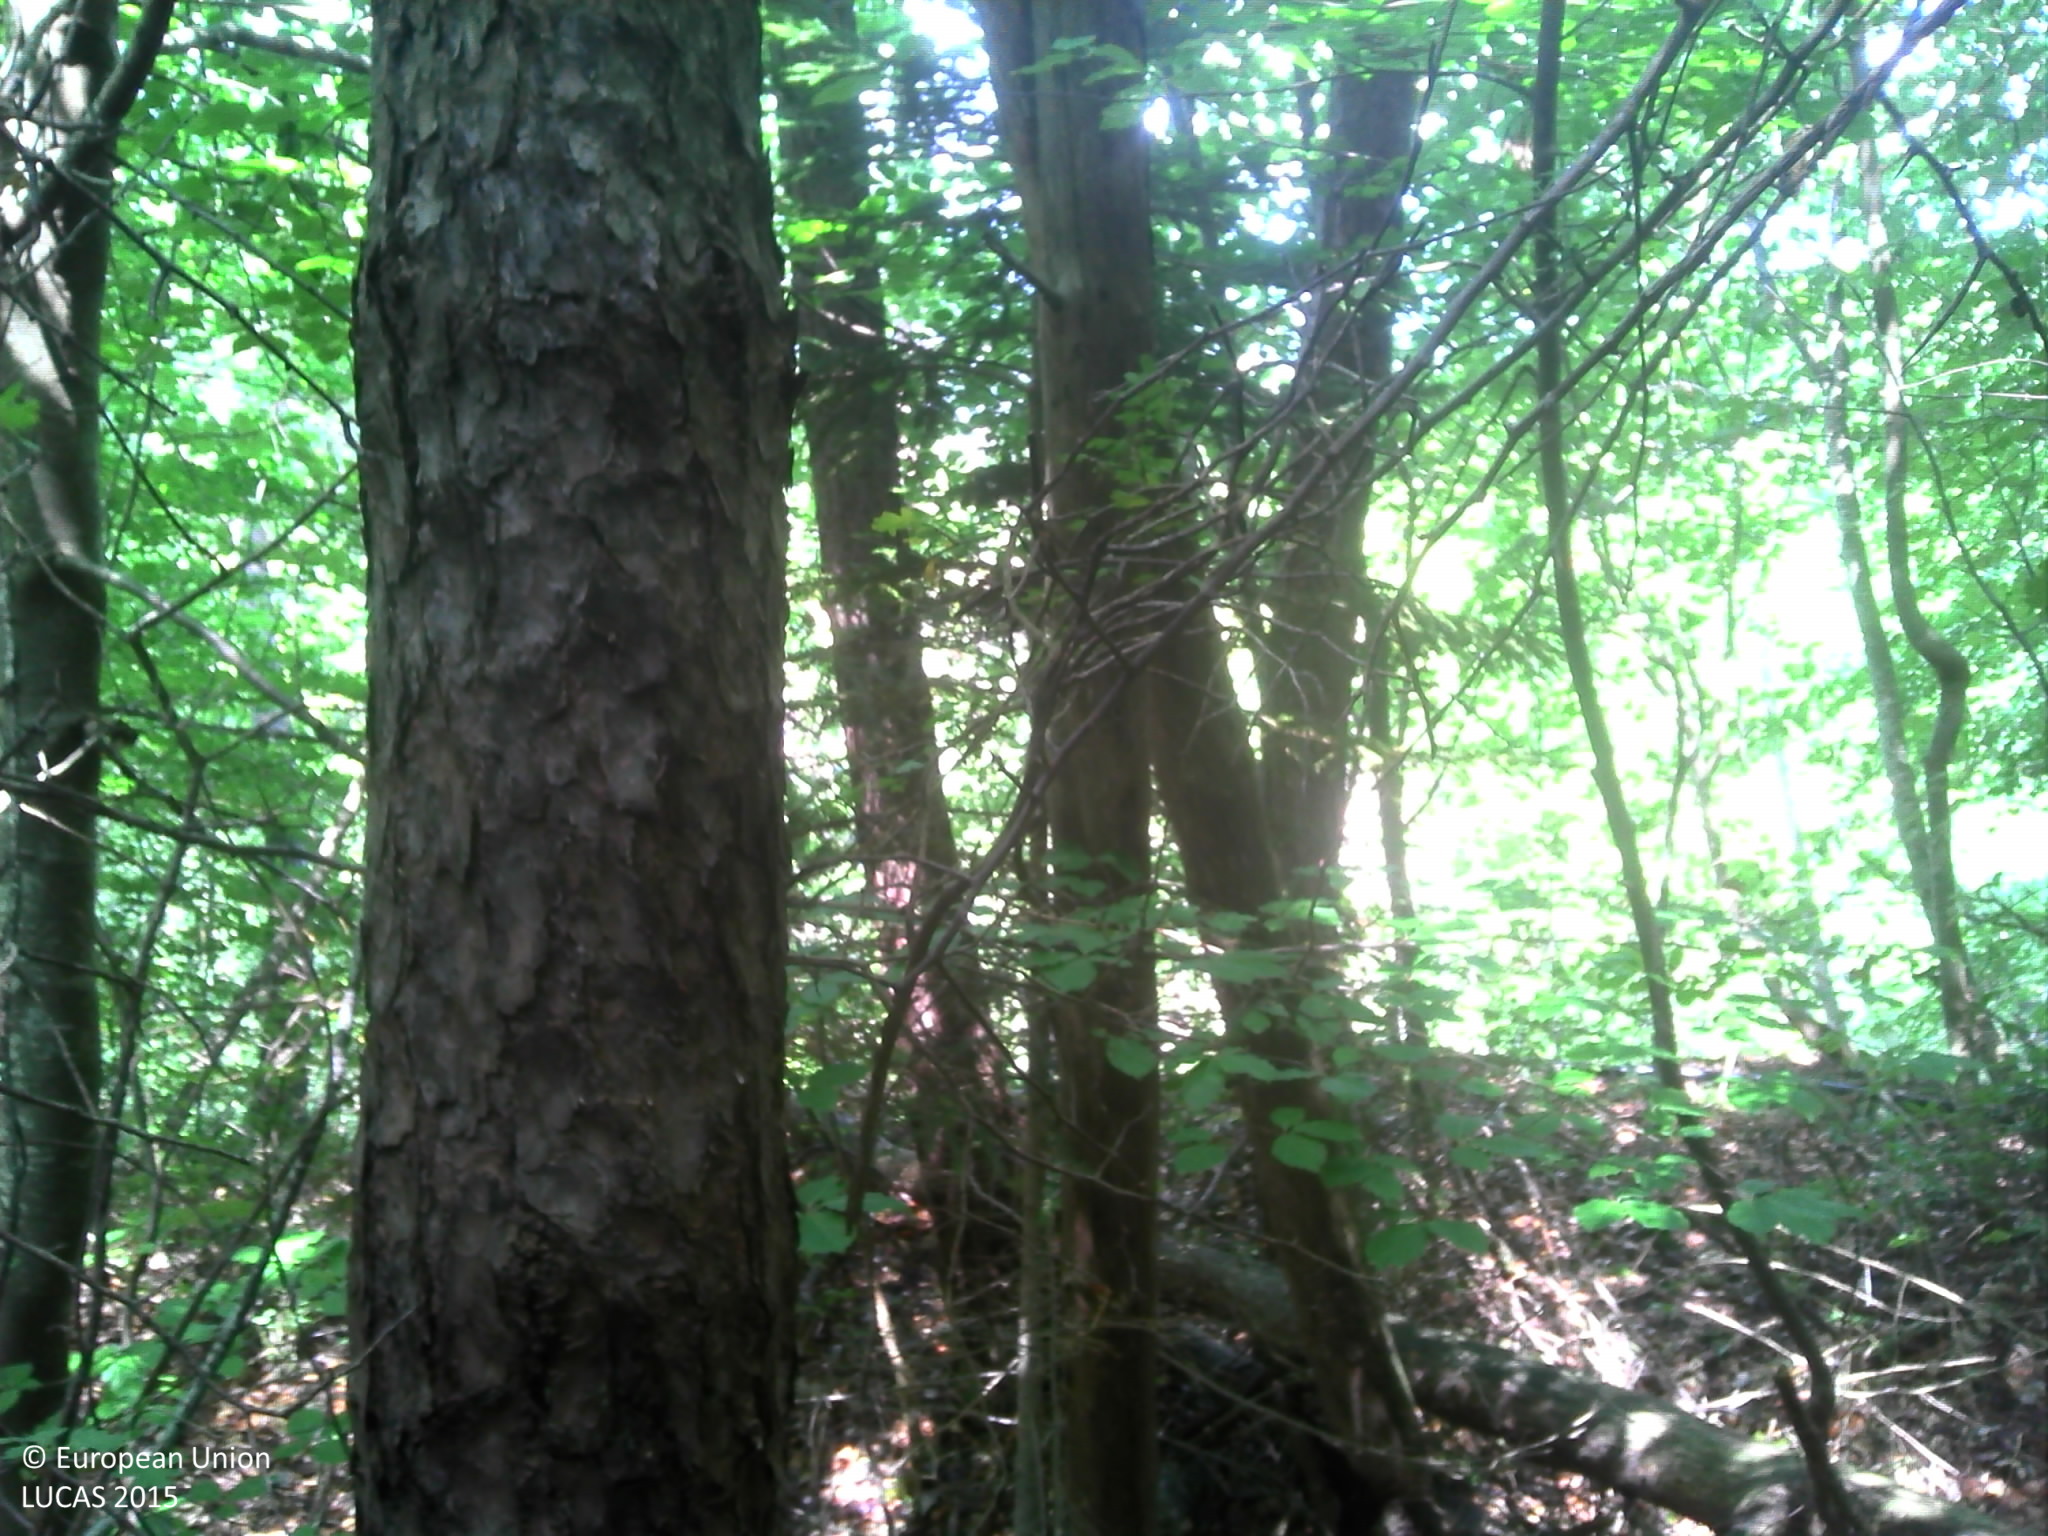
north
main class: Woodland
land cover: Spruce dominated mixed woodland
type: coniferous forest of the mediterranean region
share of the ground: > 75 %
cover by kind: coniferous forest trees 50 %, broadleaved forest trees 35 %, shrubs 10 %, herbaceous plants 5 %
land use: Forestry
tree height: > 5 m
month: July
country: FR
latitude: 44.5029
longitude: 6.3465
